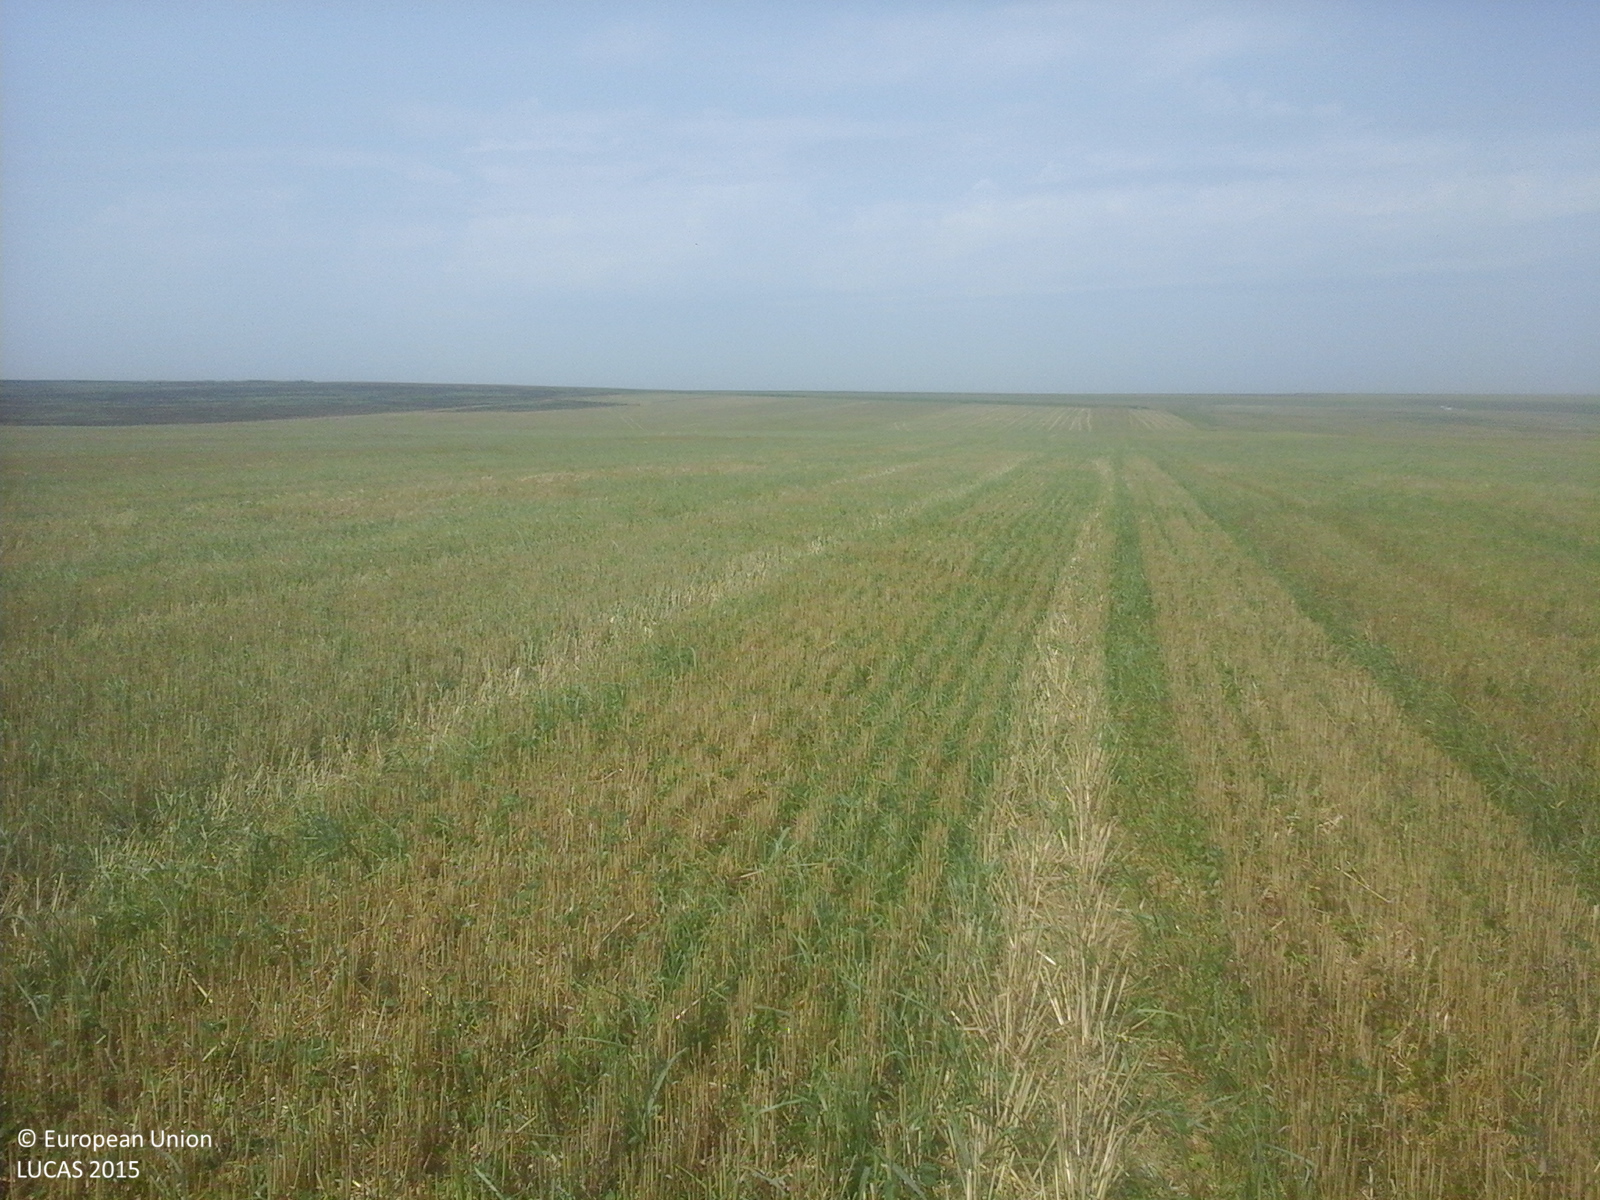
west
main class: Cropland
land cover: Durum wheat
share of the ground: > 75 %
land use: Agriculture (excluding fallow land and kitchen gardens)
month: August
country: RO
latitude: 43.8664
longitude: 28.2115
